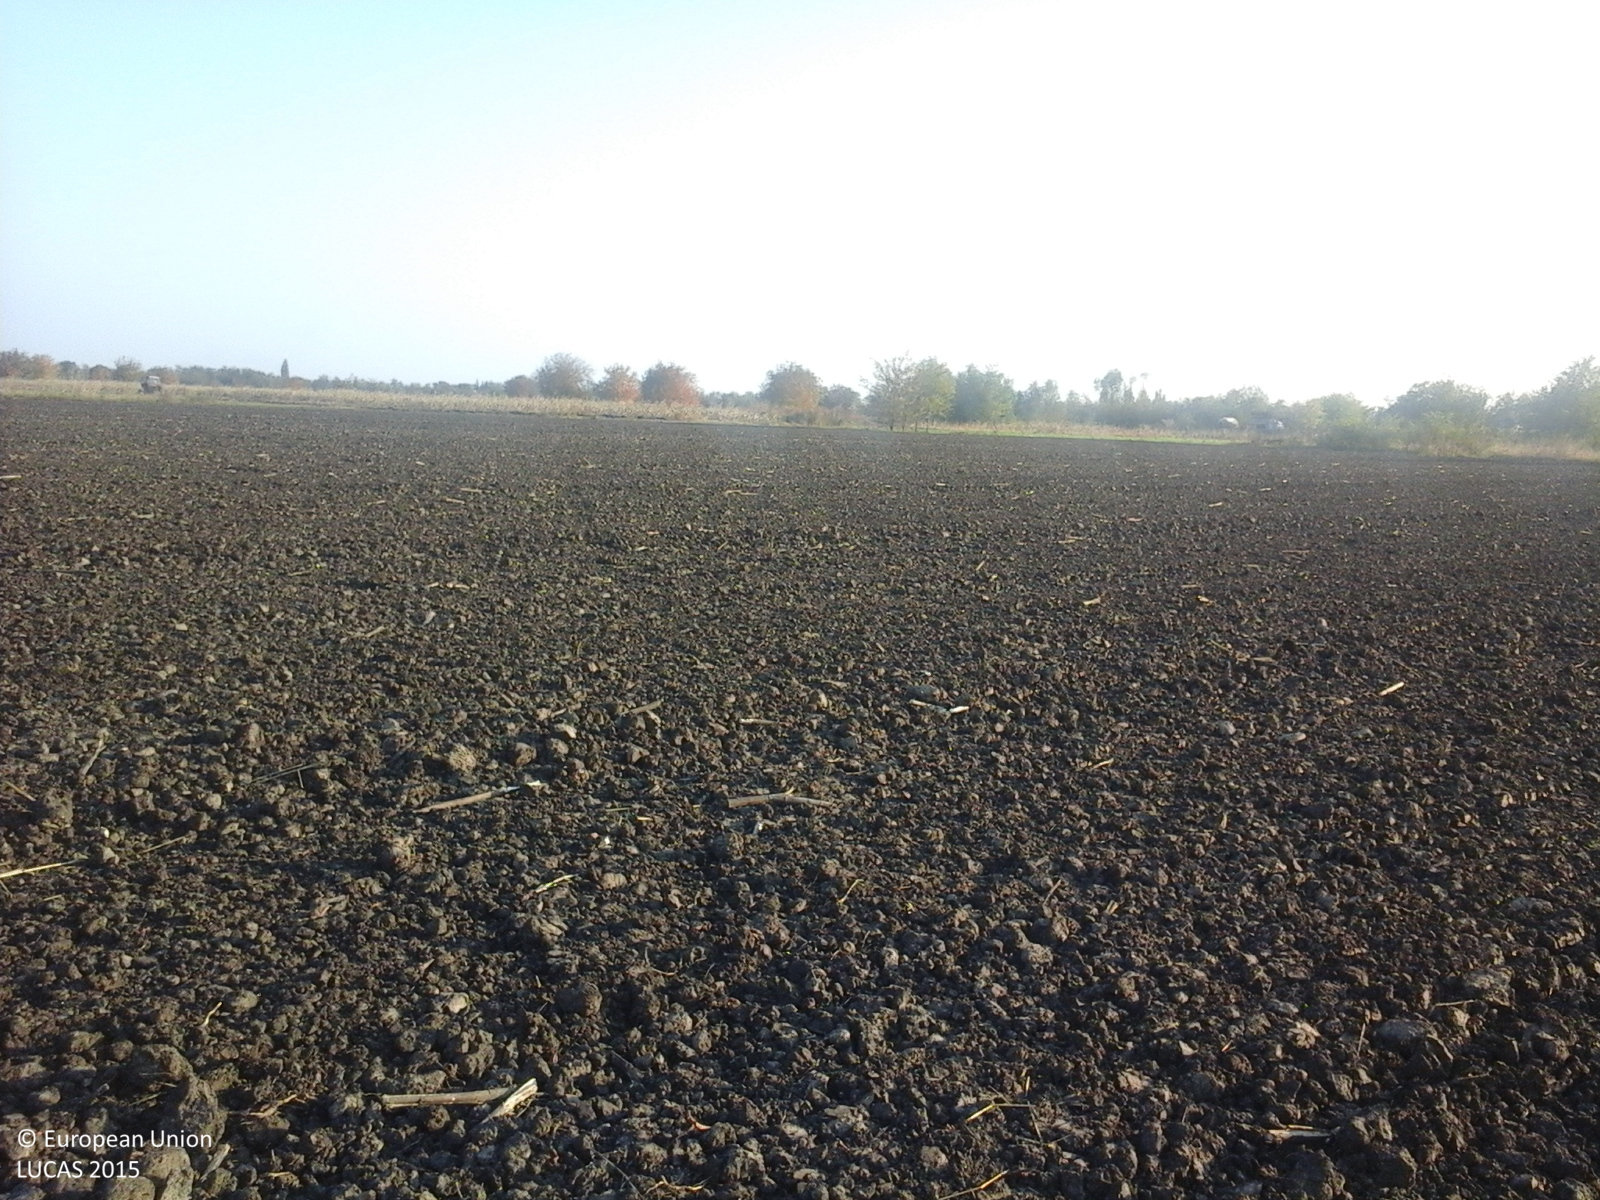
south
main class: Cropland
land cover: Sunflower
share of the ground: < 10 %
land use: Agriculture (excluding fallow land and kitchen gardens)
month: October
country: RO
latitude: 45.2018
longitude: 26.9782
